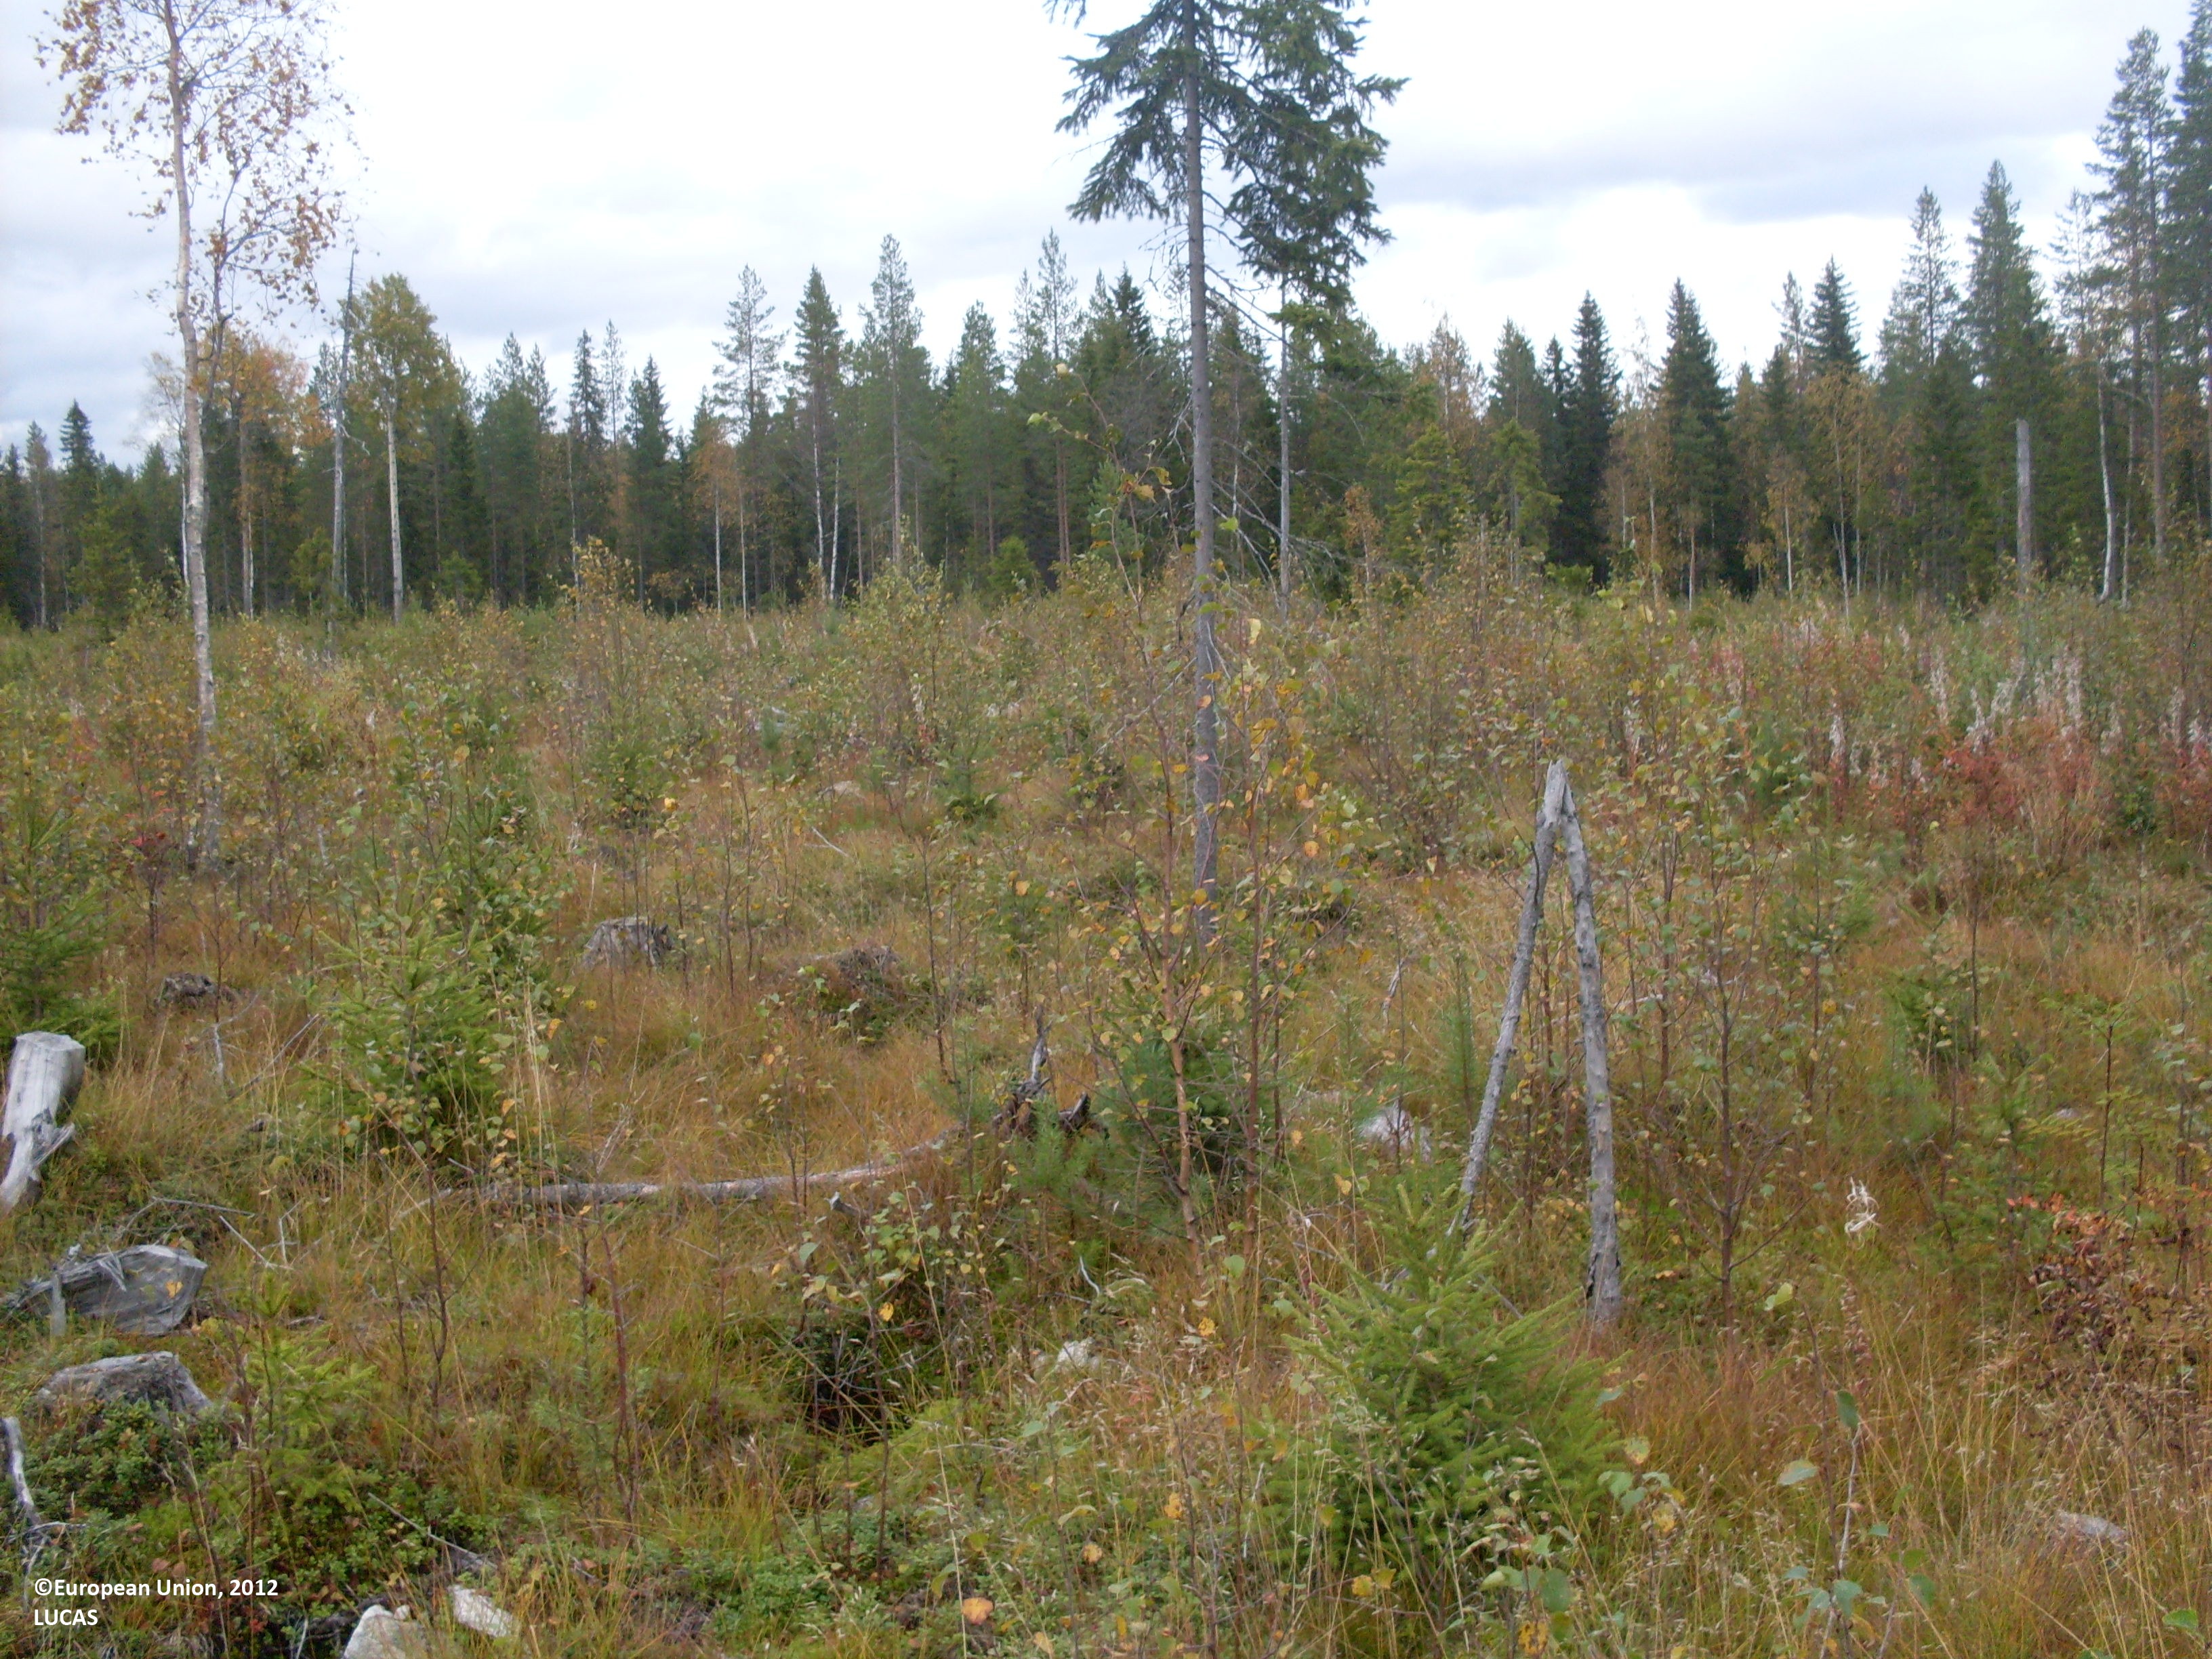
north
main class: Woodland
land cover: Pine dominated mixed woodland
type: boreal forest
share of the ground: 25 - 50 %
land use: Forestry
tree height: < 5 m
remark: Nursery
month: September
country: FI
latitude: 64.2807
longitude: 28.3700
